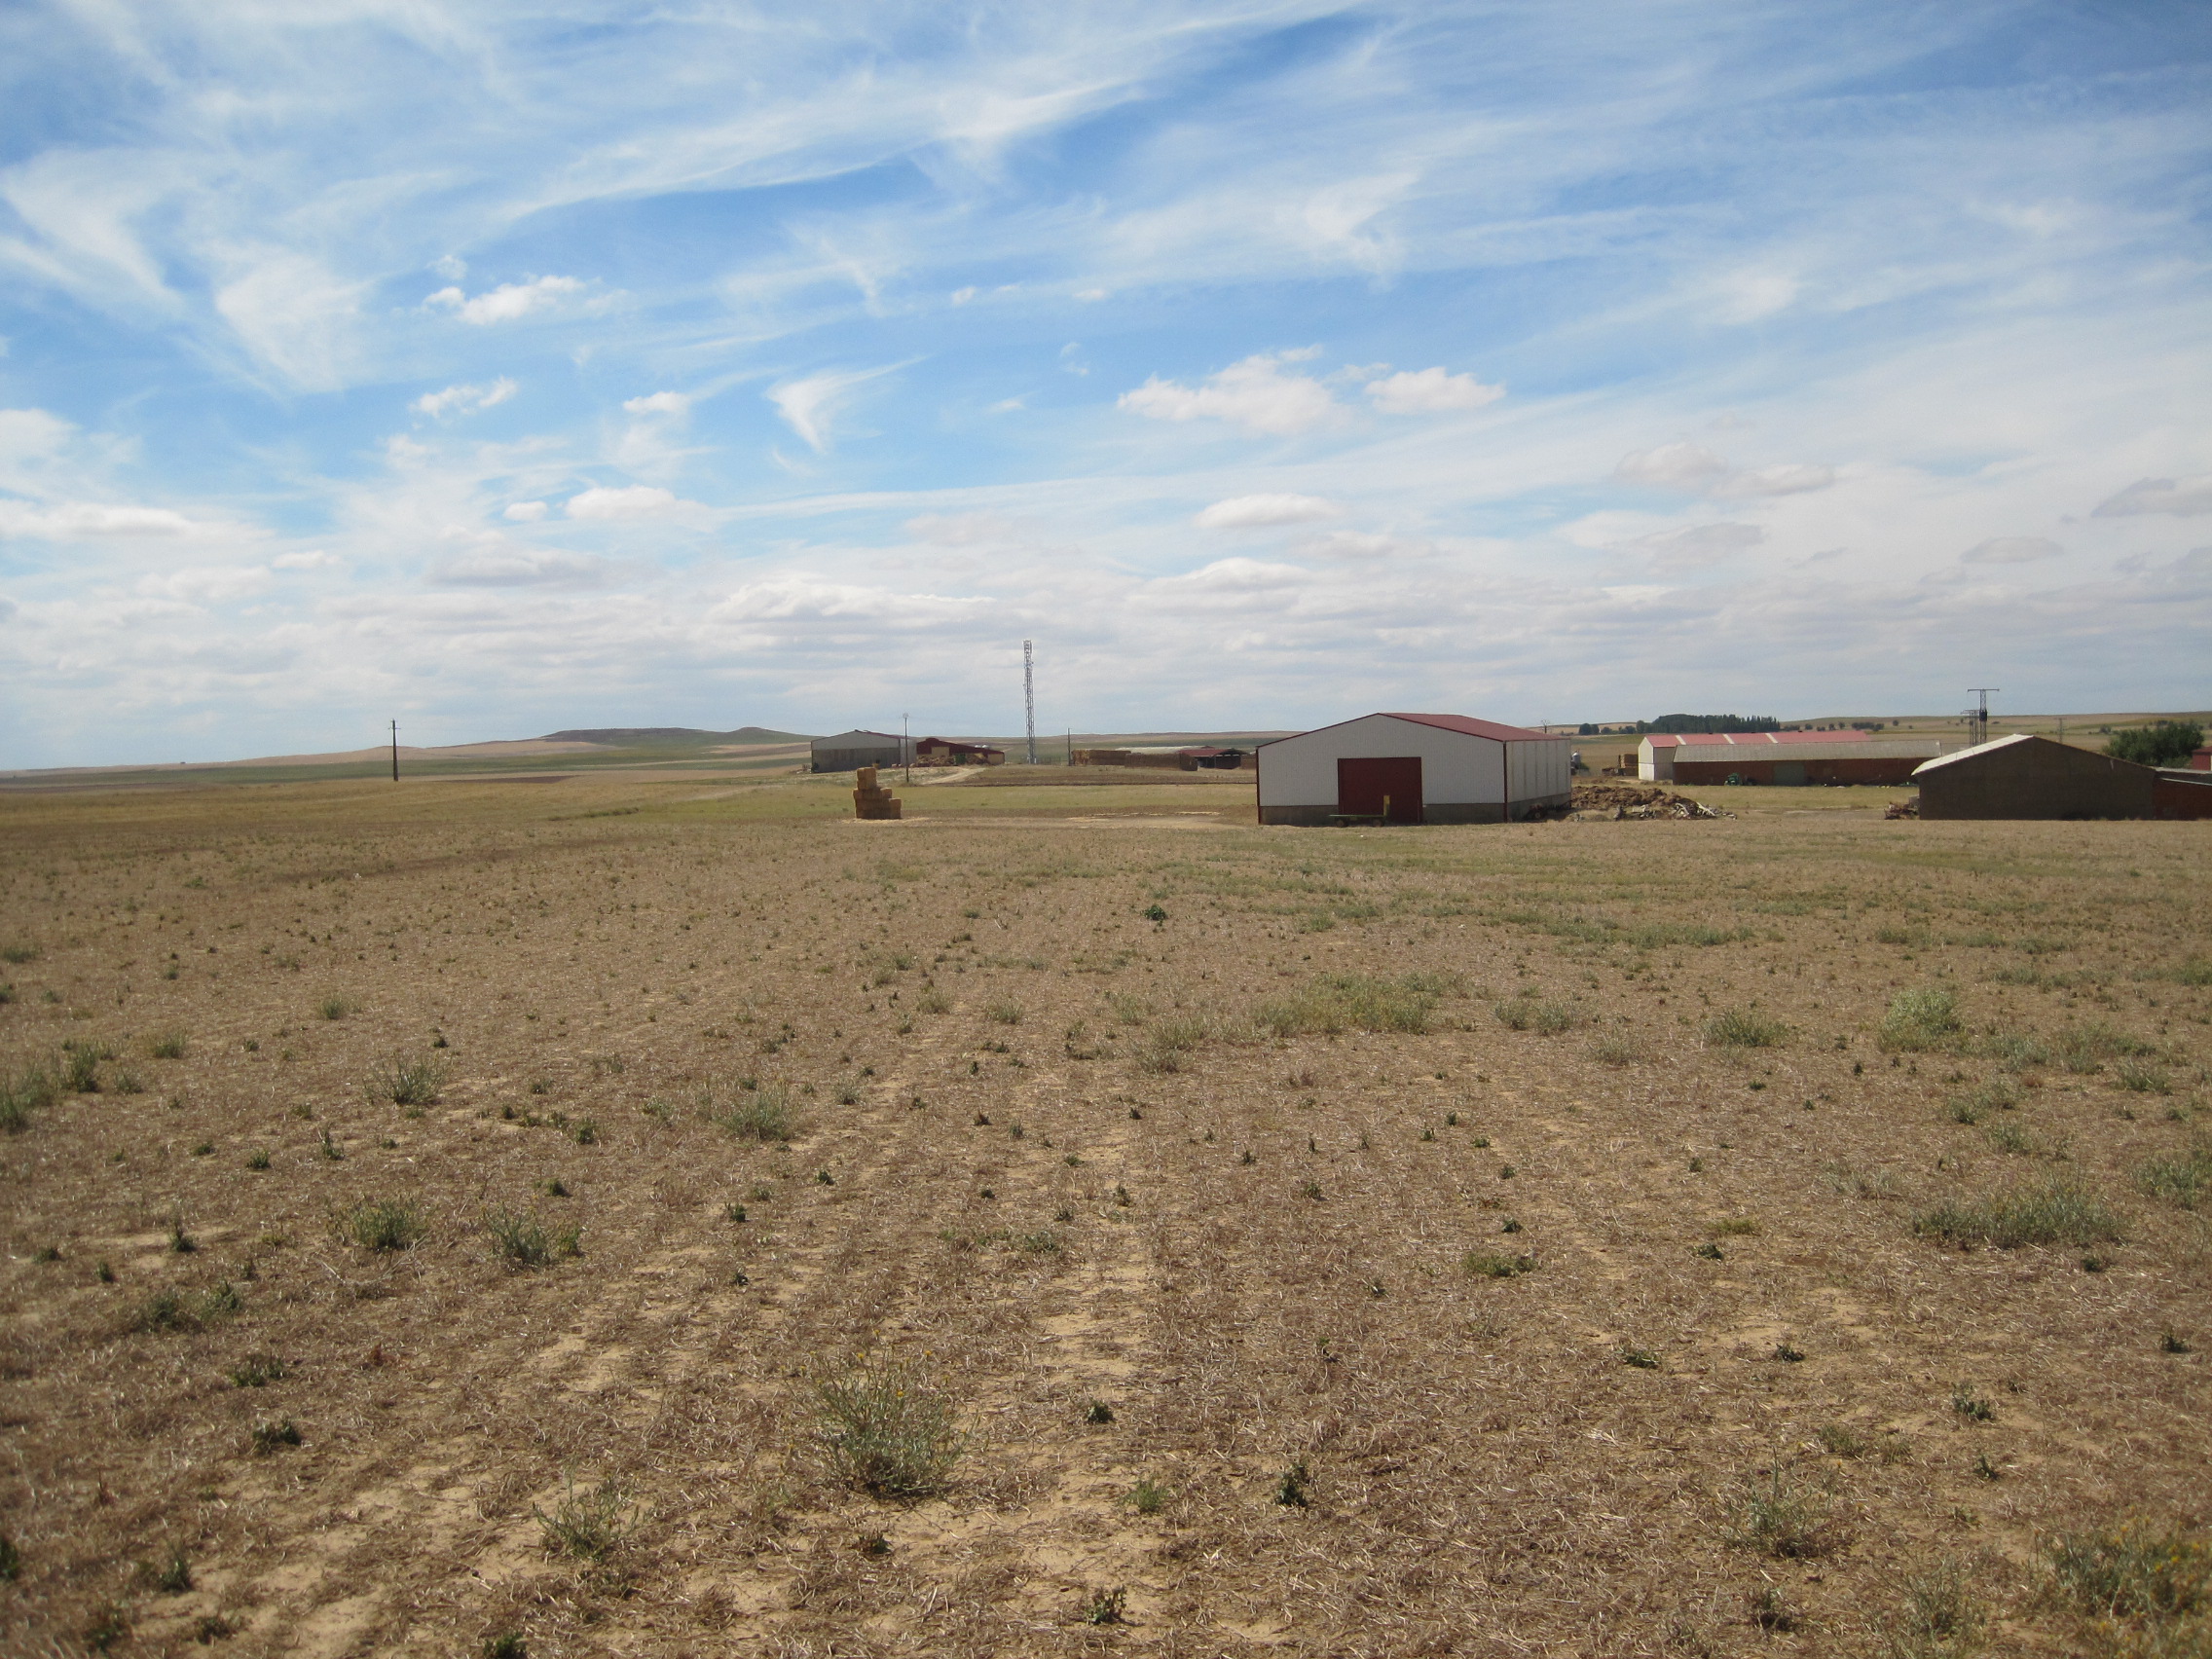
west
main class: Cropland
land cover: Dry pulses
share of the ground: < 10 %
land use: Agriculture (excluding fallow land and kitchen gardens)
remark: Harvested field
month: July
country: ES
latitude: 41.9792
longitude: -5.1797
